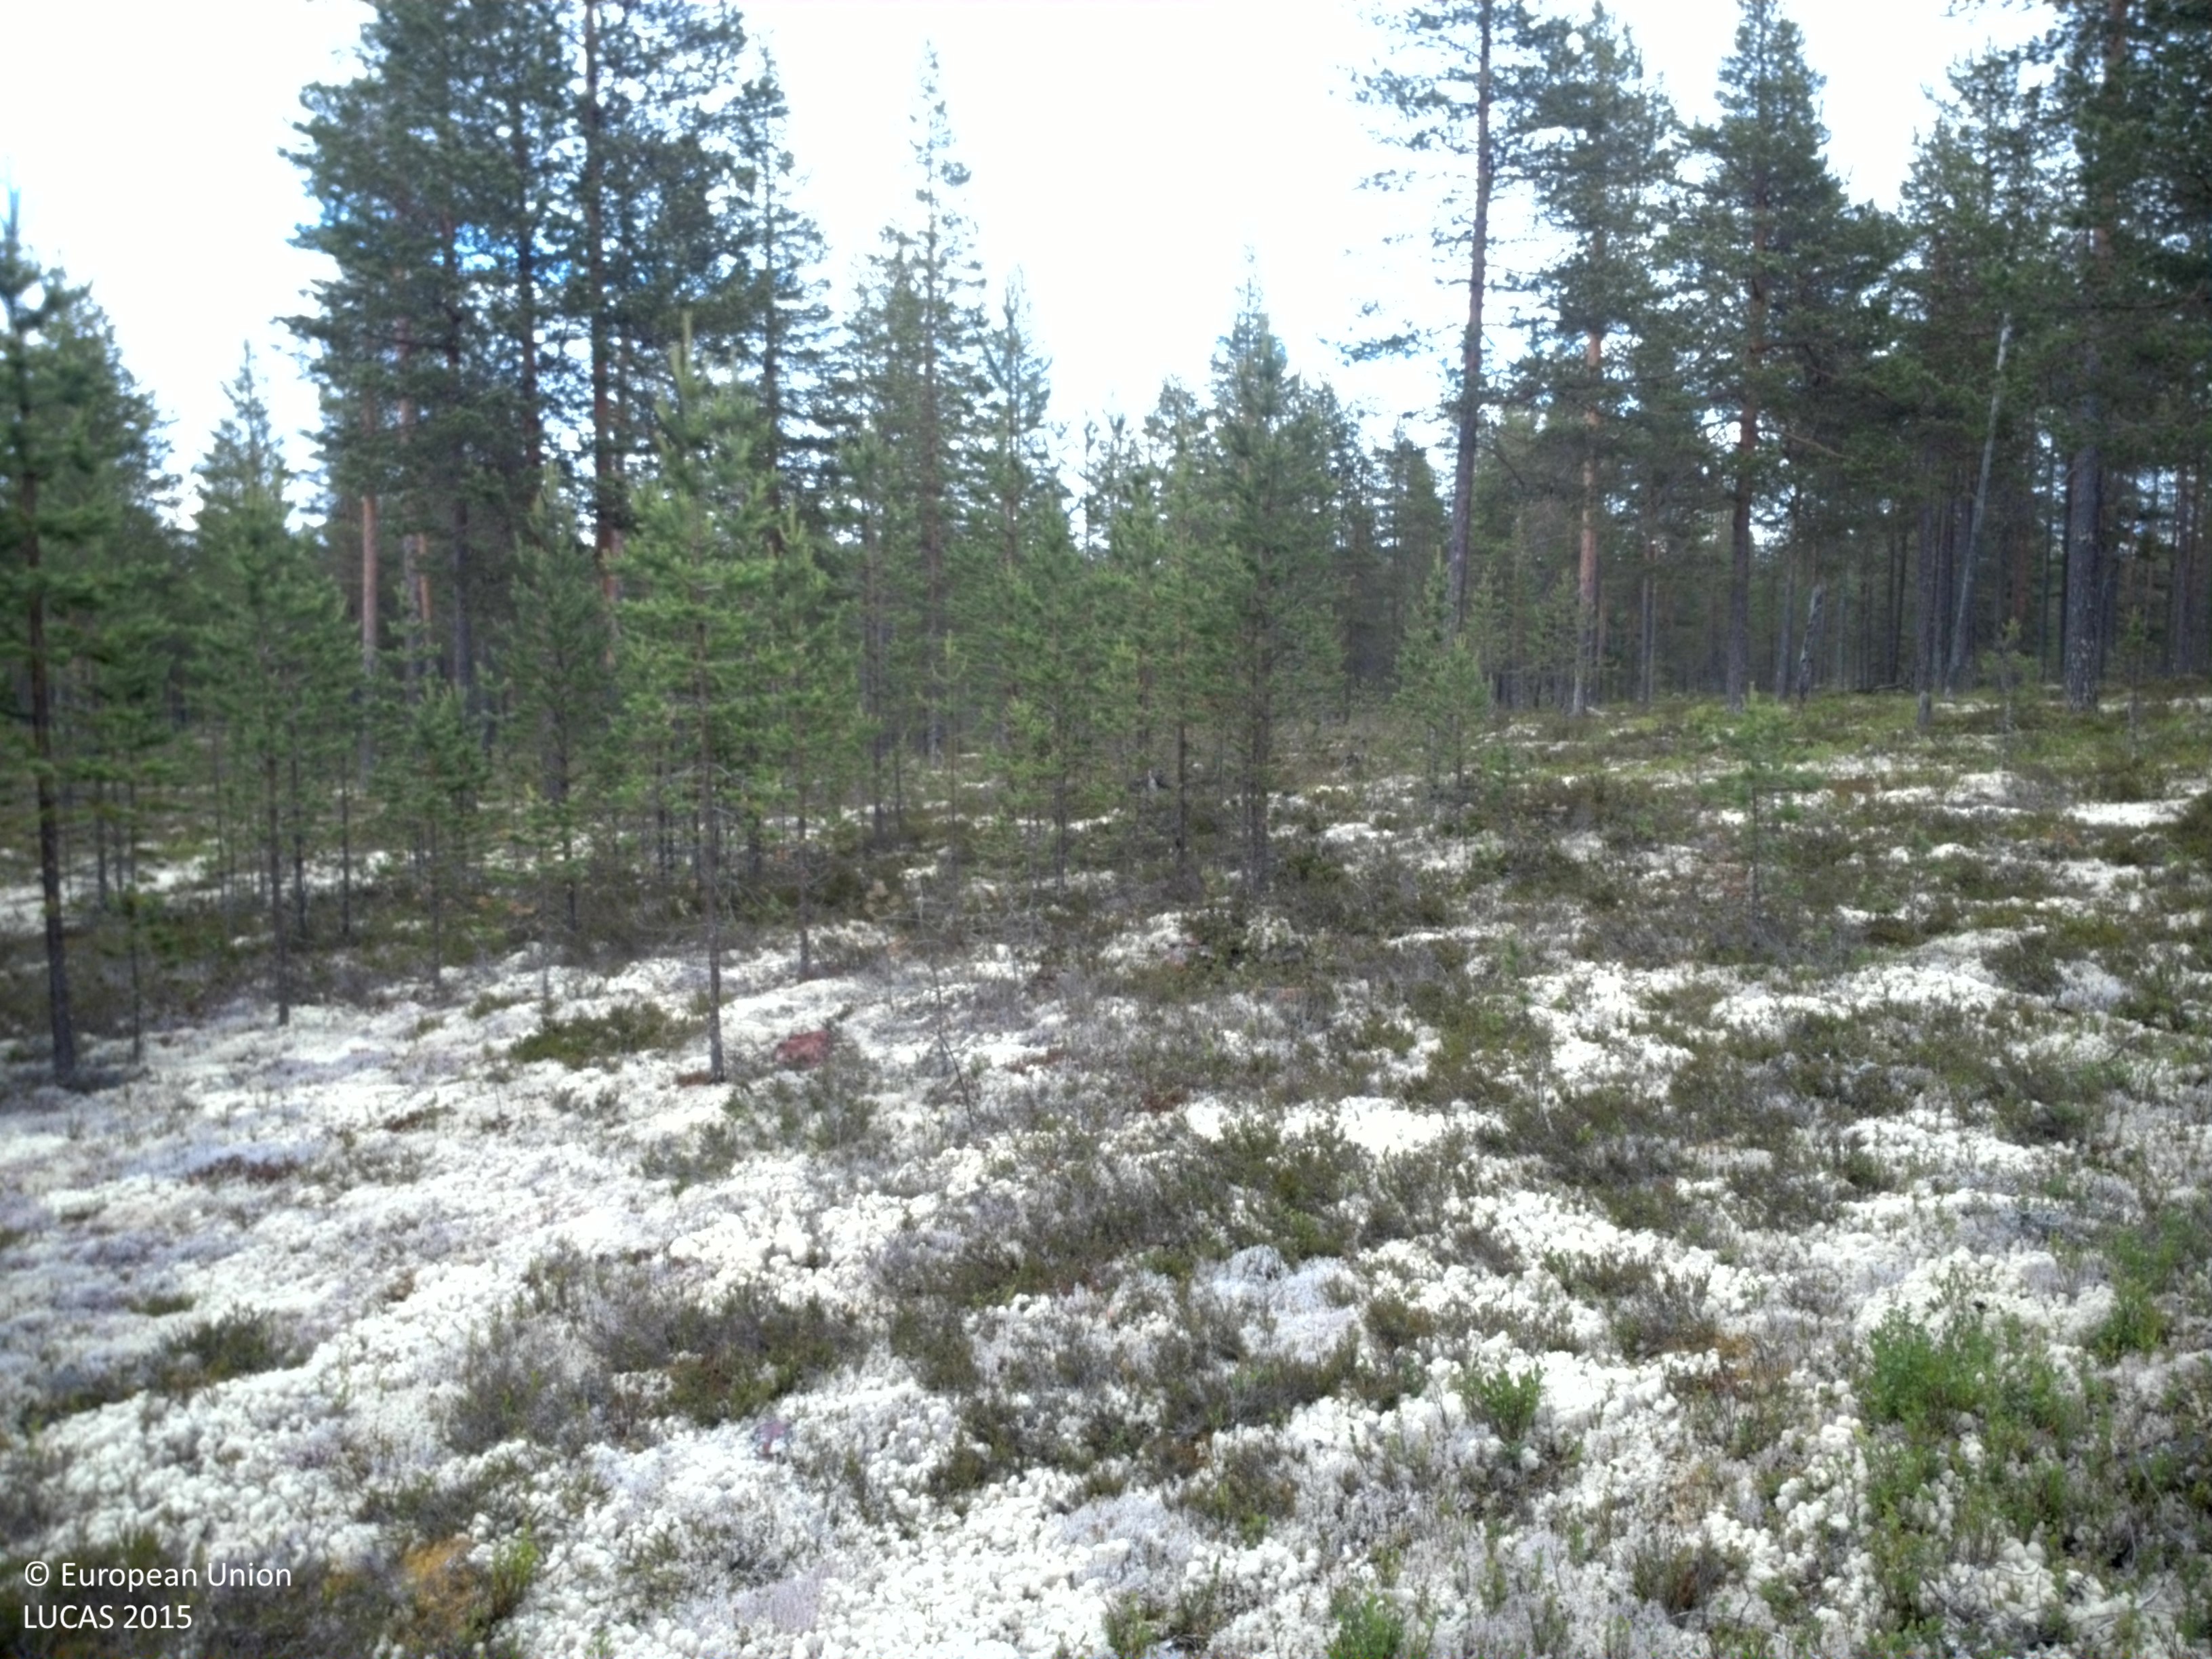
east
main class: Woodland
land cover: Pine dominated coniferous woodland
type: boreal forest
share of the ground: 25 - 50 %
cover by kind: coniferous forest trees 35 %, lichens and mosses 35 %, shrubs 30 %
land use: Community services
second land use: Forestry
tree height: < 5 m
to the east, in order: Pine dominated coniferous woodland
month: July
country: SE
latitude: 61.5414
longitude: 13.5800
